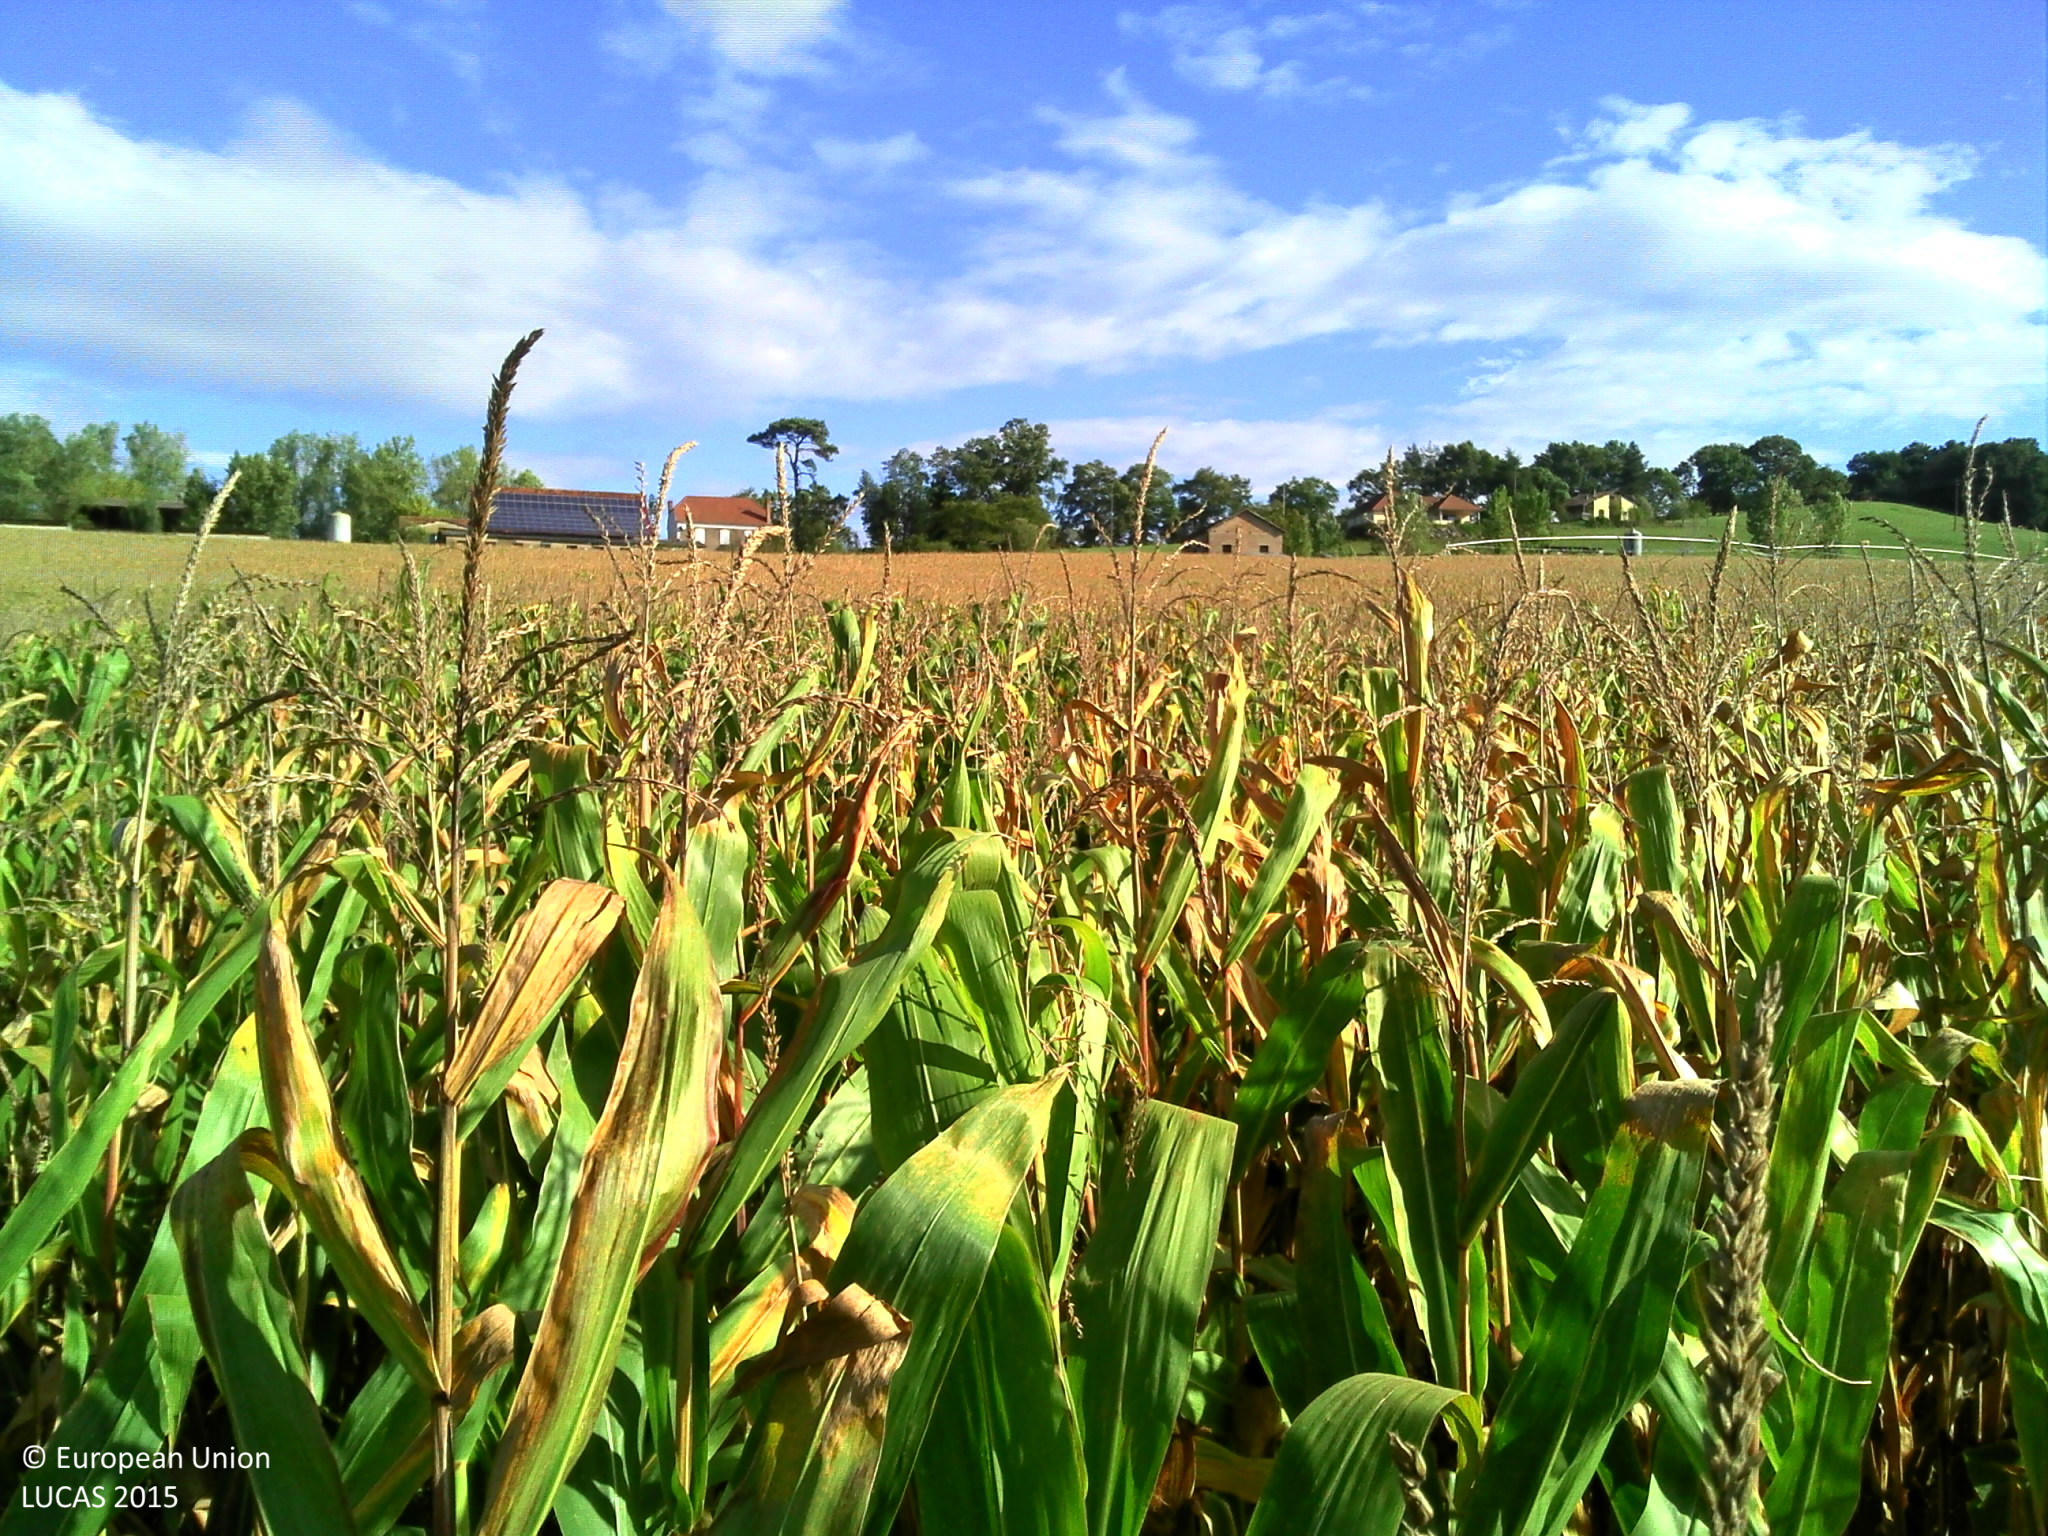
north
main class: Cropland
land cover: Maize
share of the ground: > 75 %
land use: Agriculture (excluding fallow land and kitchen gardens)
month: September
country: FR
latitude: 43.4859
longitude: -0.7063
